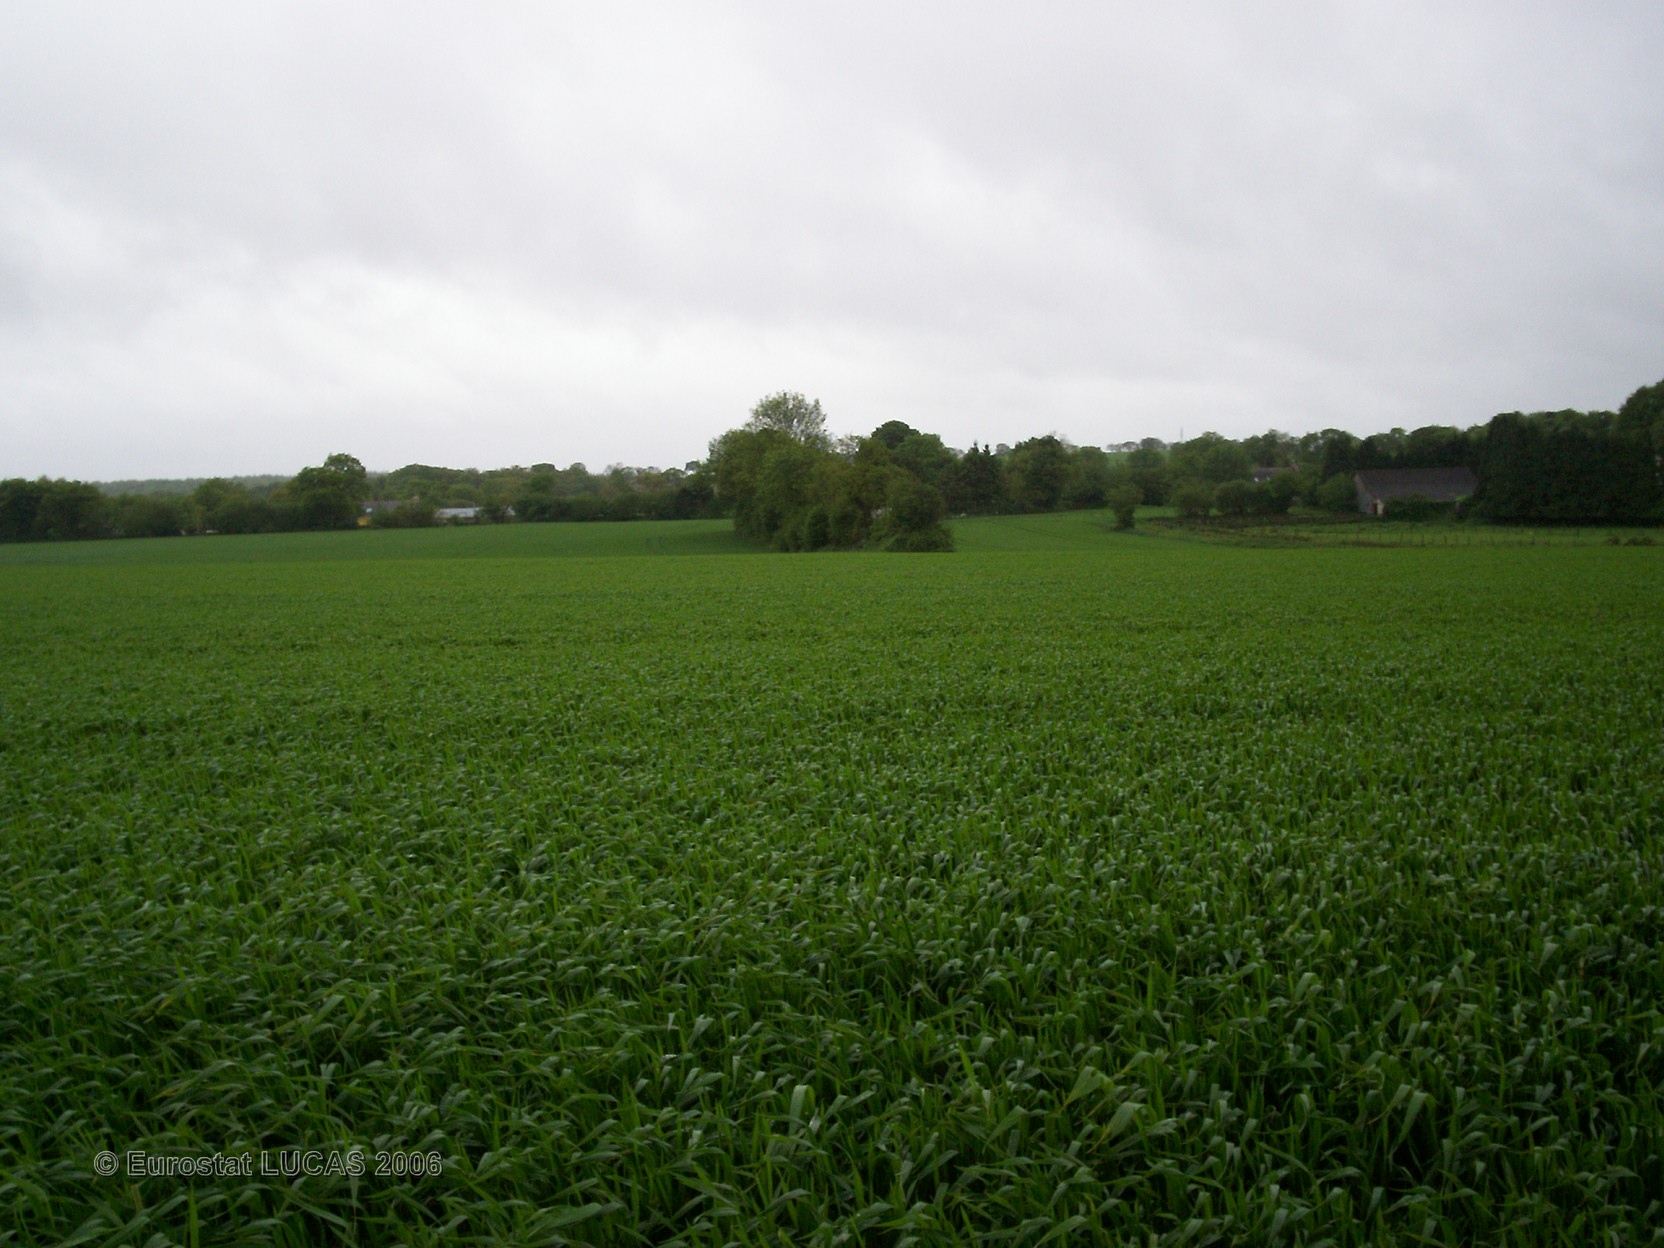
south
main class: Cropland
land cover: Common wheat
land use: Agriculture (excluding fallow land and kitchen gardens)
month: May
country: FR
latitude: 48.3203
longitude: -3.6343
